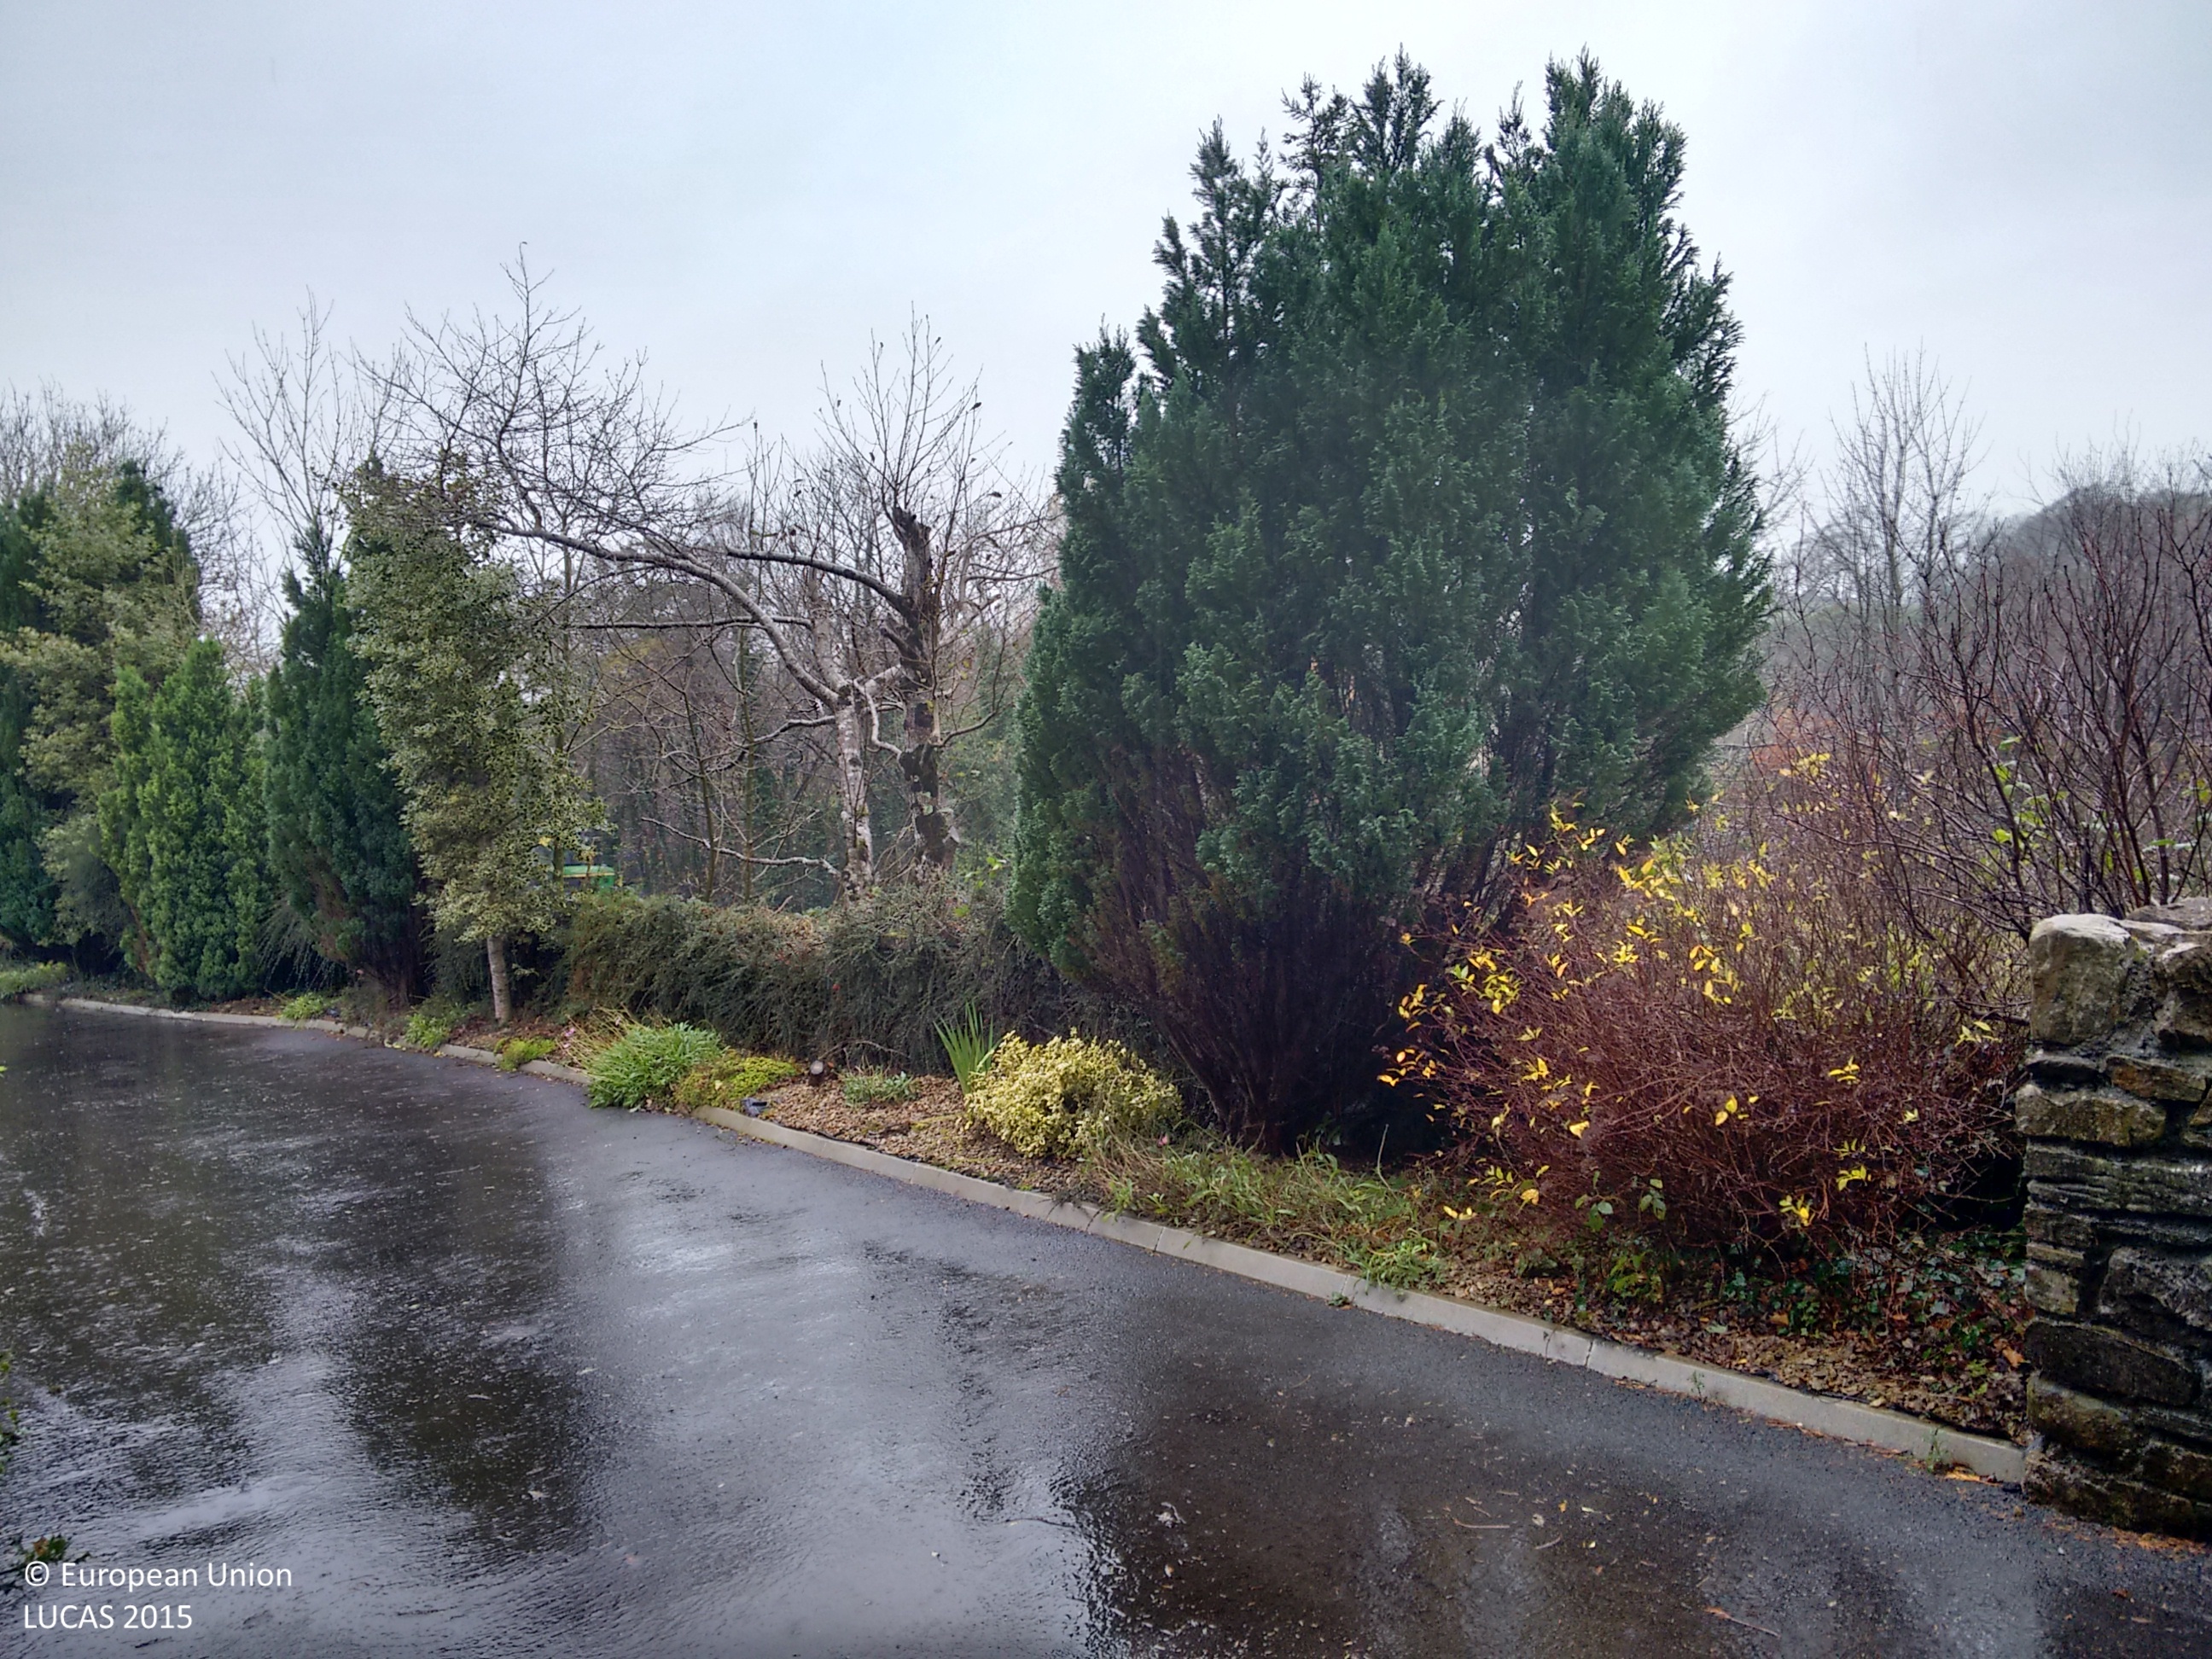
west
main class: Grassland
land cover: Grassland without tree/shrub cover
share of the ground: > 75 %
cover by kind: herbaceous plants 100 %
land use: Residential
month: November
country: IE
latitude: 54.5251
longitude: -8.1475
